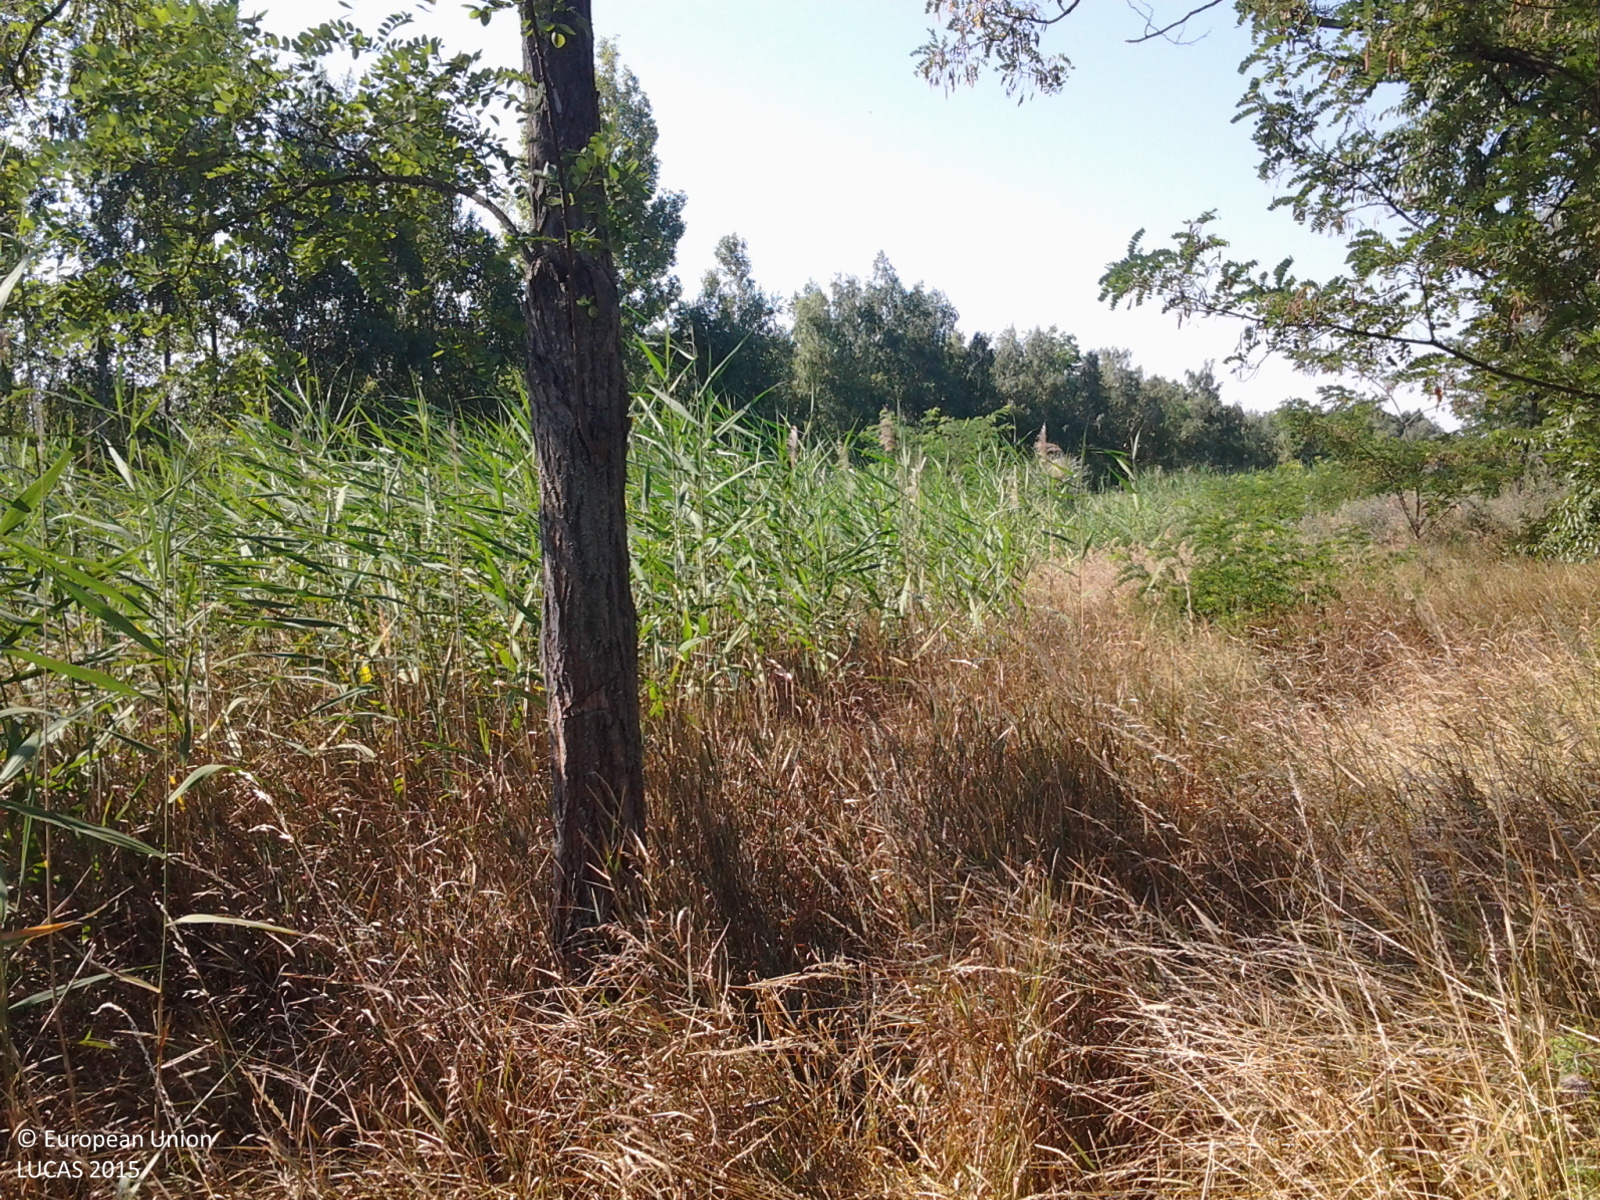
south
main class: Woodland
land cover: Broadleaved woodland
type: mire and swamp forests
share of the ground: 25 - 50 %
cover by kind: herbaceous plants 70 %, broadleaved forest trees 30 %
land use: Abandoned areas
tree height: < 5 m
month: July
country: HU
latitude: 47.3676
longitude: 20.5853
